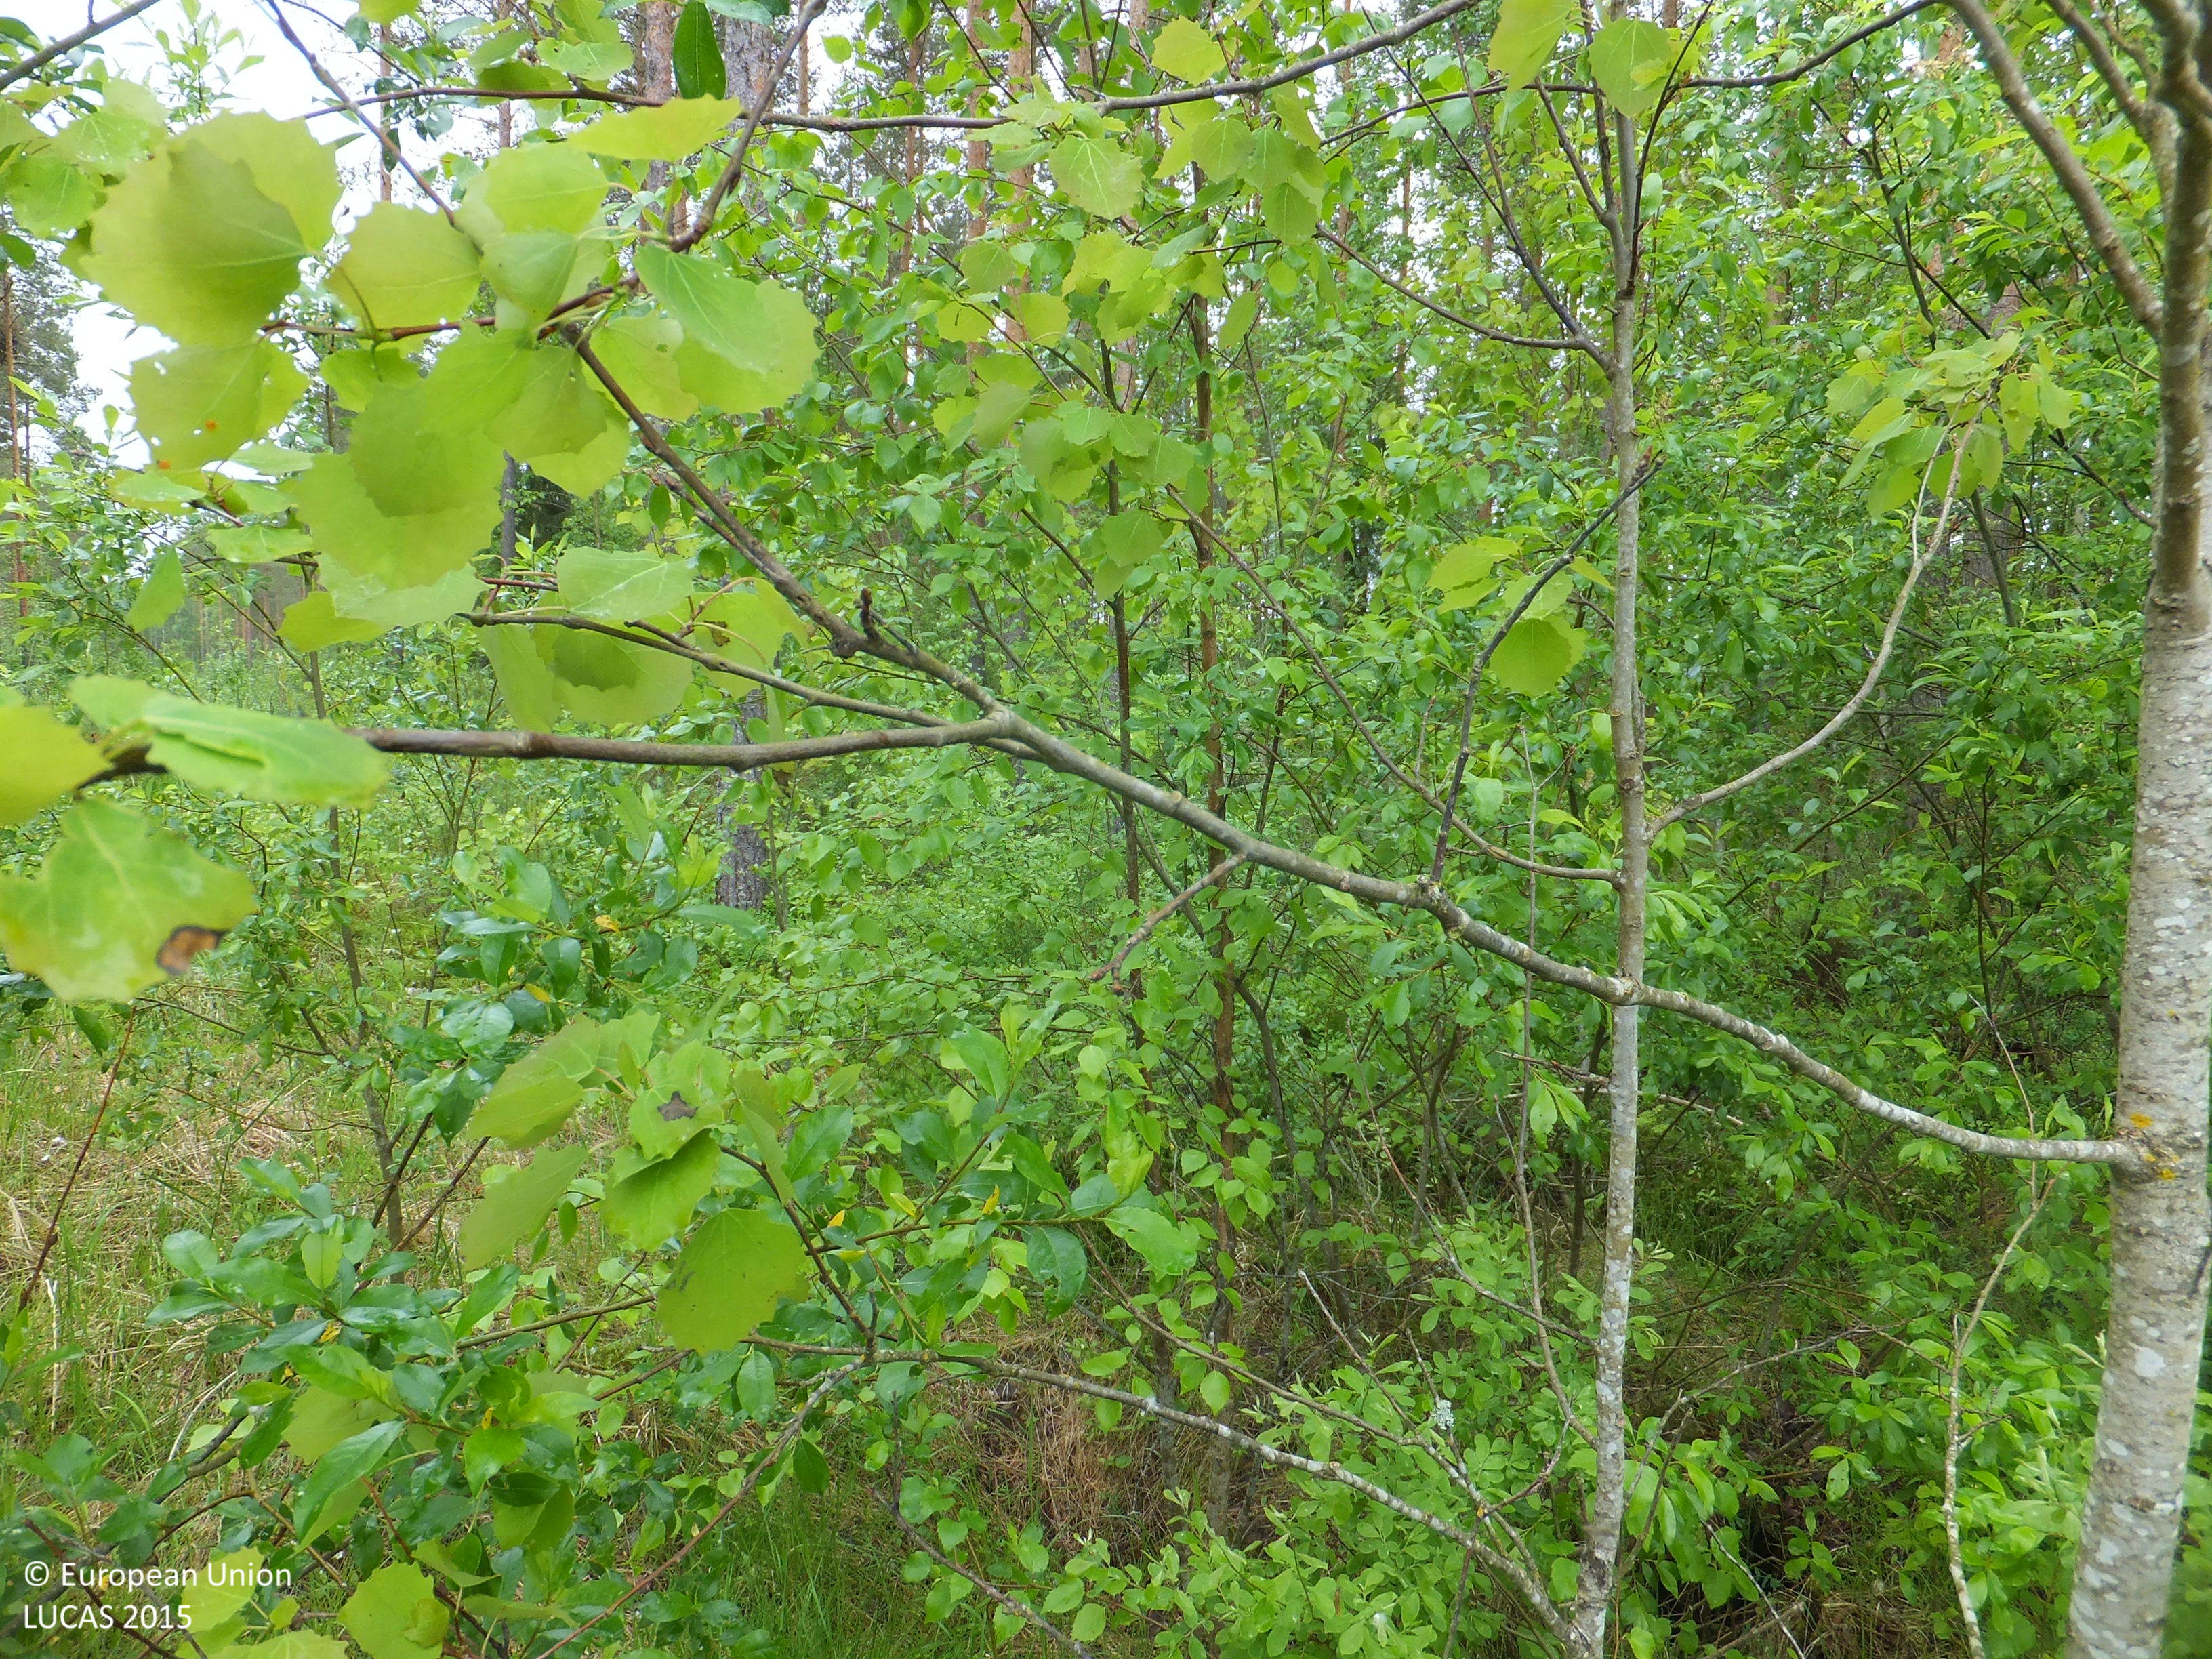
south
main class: Woodland
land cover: Pine dominated mixed woodland
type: boreal forest
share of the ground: > 75 %
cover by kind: coniferous forest trees 55 %, broadleaved forest trees 20 %, shrubs 15 %, herbaceous plants 5 %, lichens and mosses 5 %
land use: Forestry
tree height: > 5 m
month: June
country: FI
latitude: 63.4563
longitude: 23.8475
